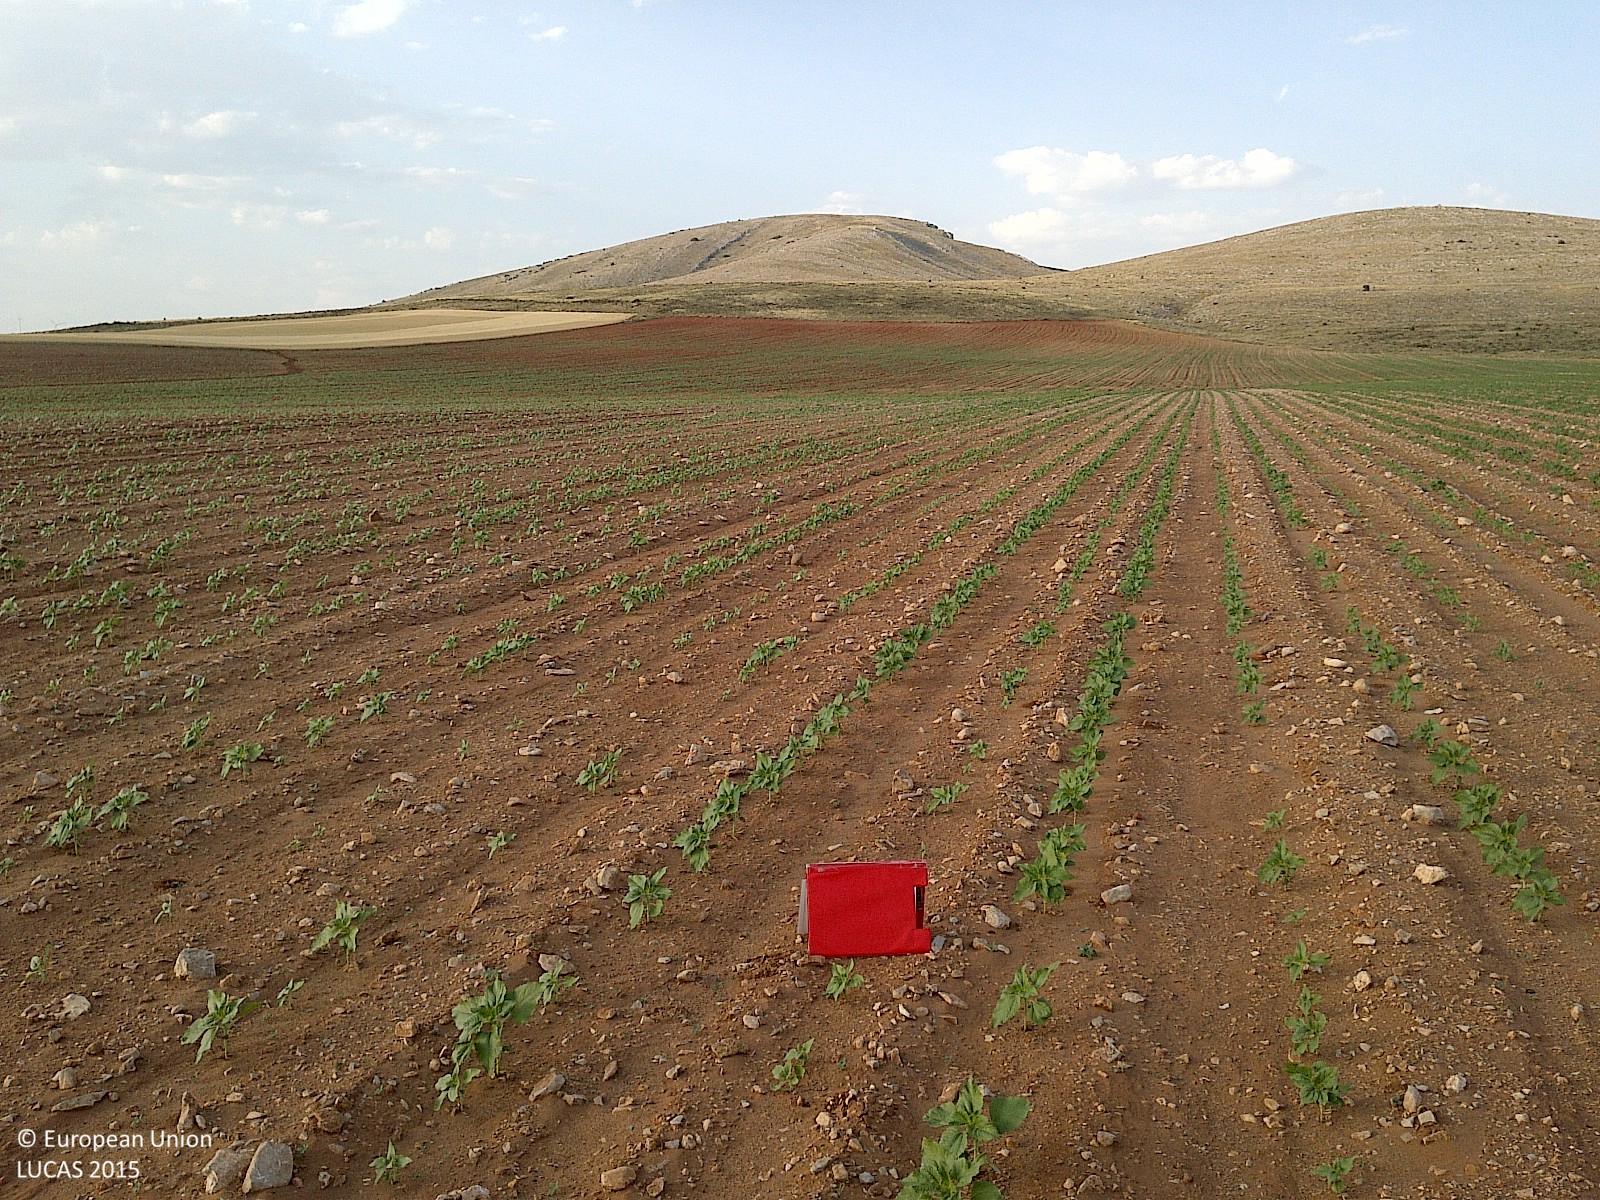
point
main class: Cropland
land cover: Sunflower
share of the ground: < 10 %
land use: Agriculture (excluding fallow land and kitchen gardens)
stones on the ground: < 10 %
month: June
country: ES
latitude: 41.6463
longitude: -2.1478
